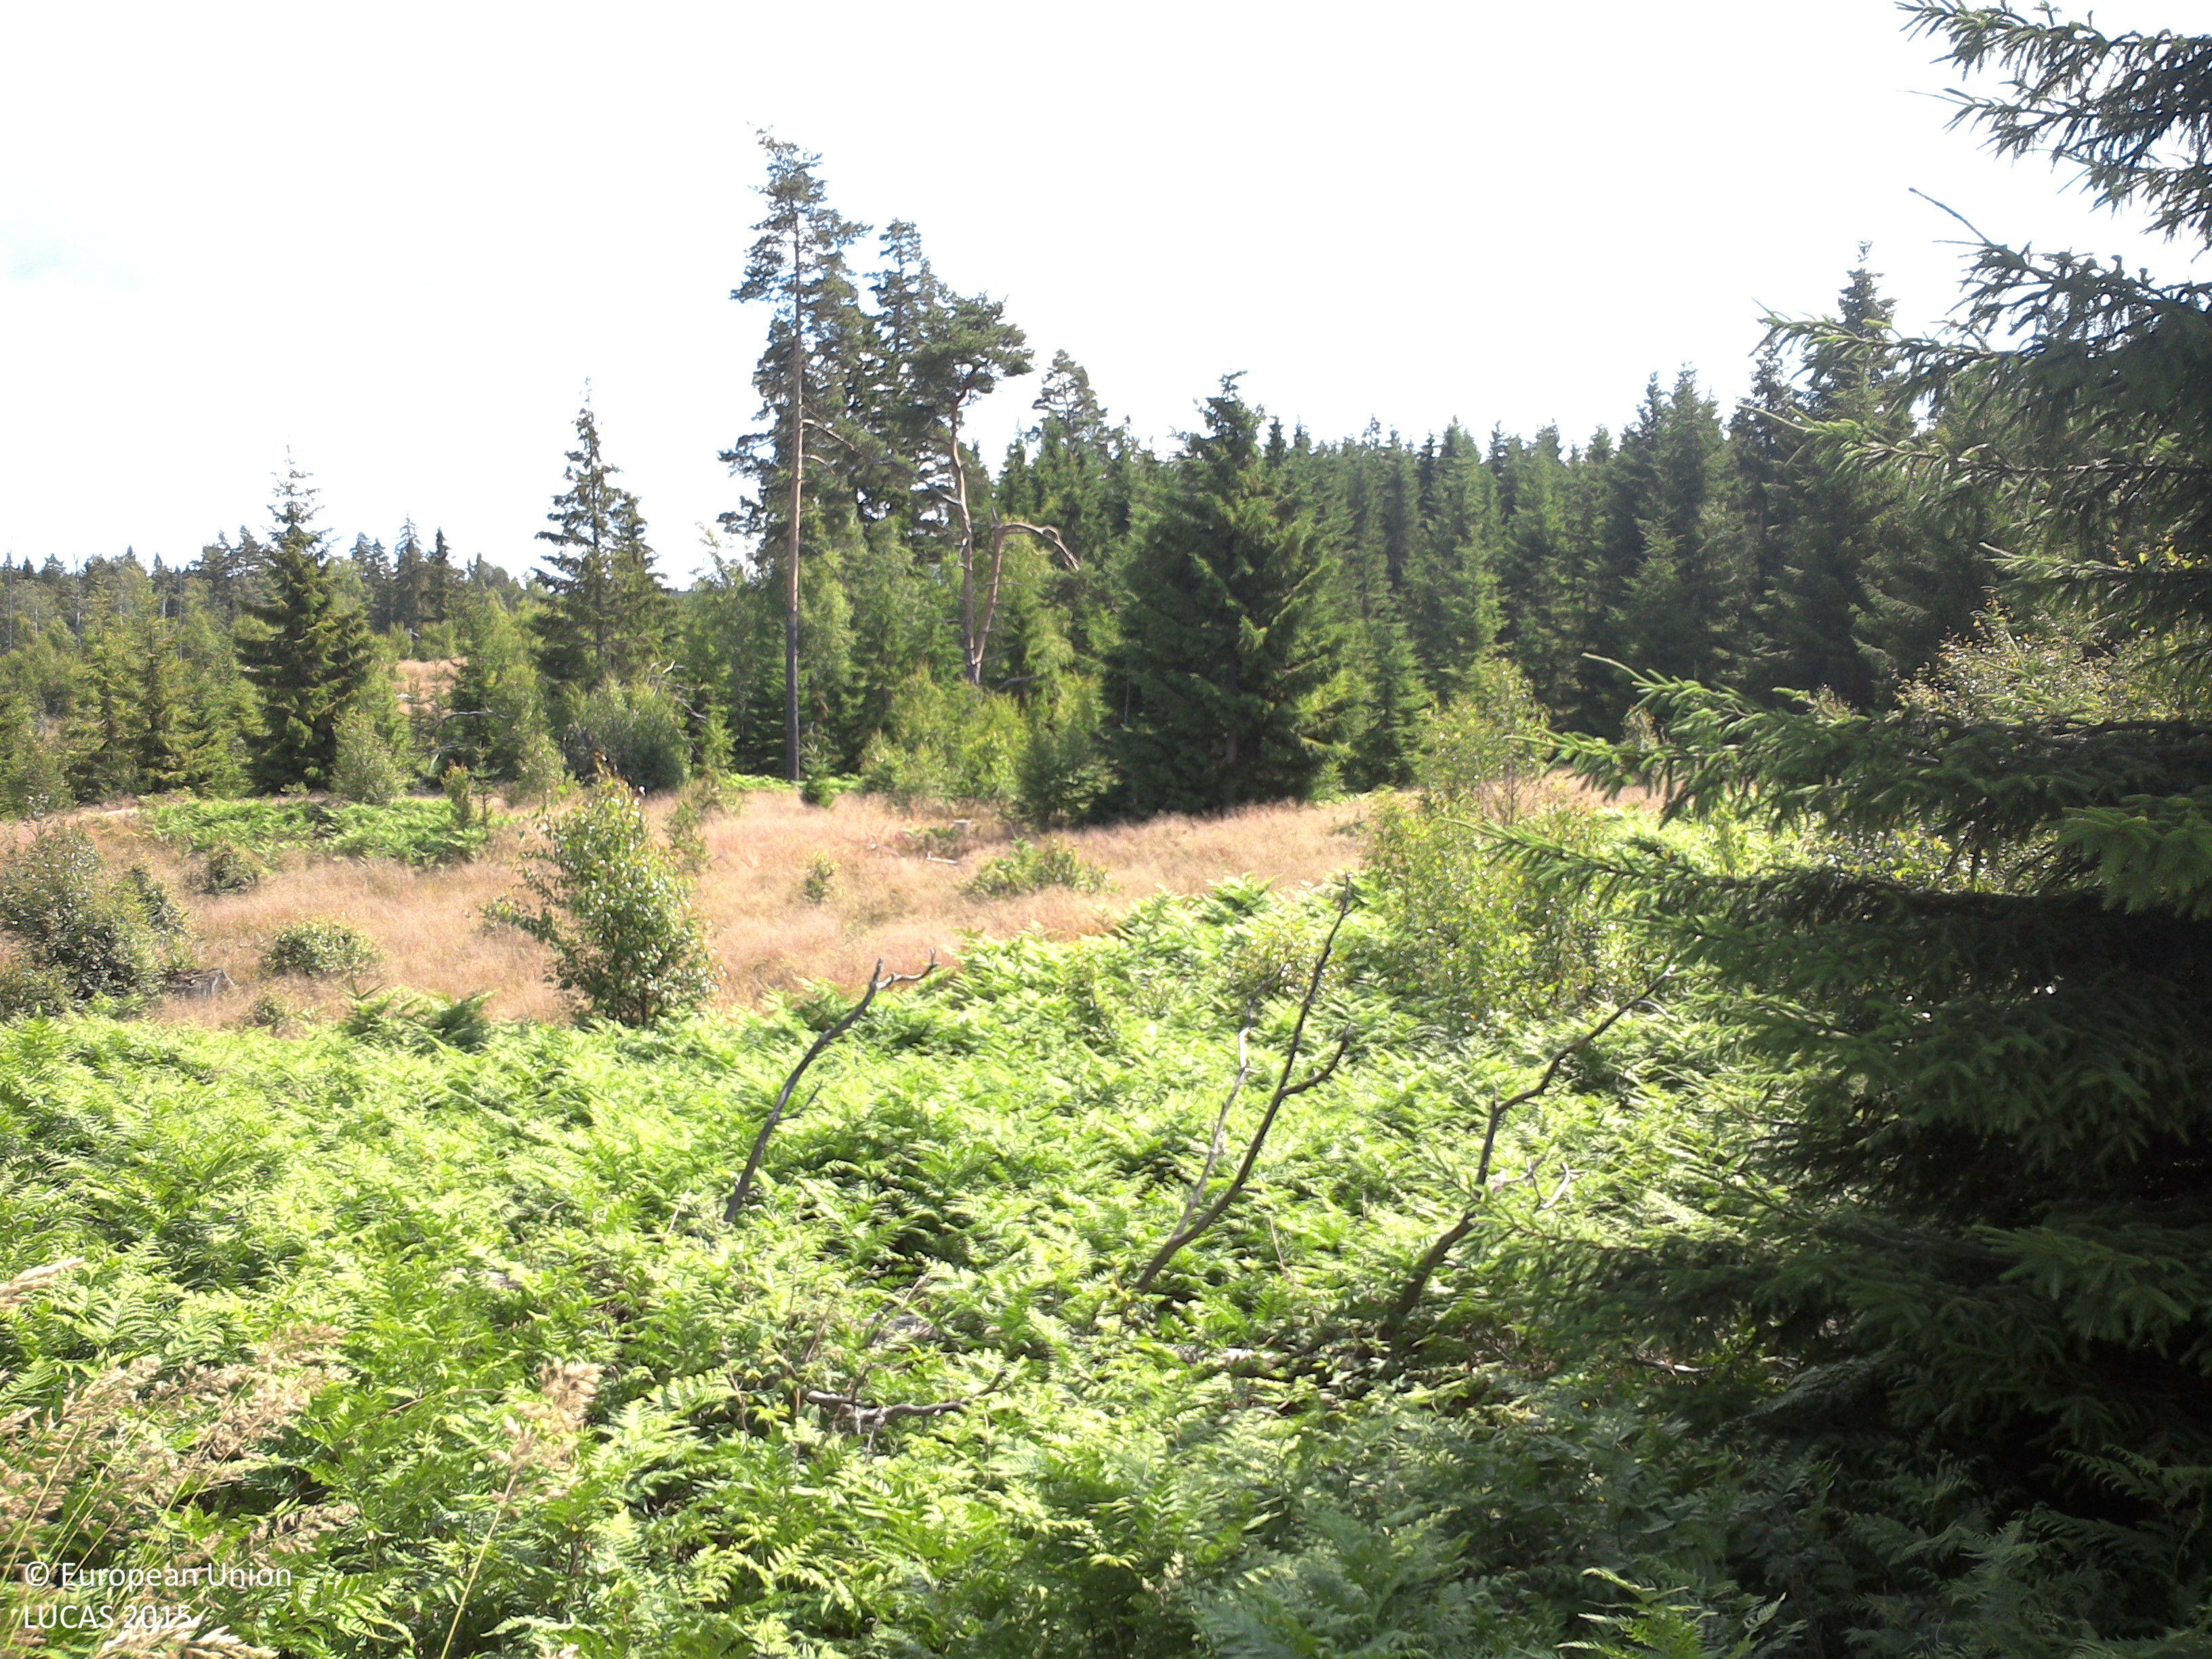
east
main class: Woodland
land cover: Spruce dominated mixed woodland
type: boreal forest
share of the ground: 50 - 75 %
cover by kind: coniferous forest trees 50 %, broadleaved forest trees 25 %, herbaceous plants 15 %, lichens and mosses 10 %
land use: Forestry
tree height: > 5 m
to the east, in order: Spruce dominated mixed woodland; Shrubland with sparse tree cover; Grassland with sparse tree/shrub cover; Spruce dominated coniferous woodland; Pine dominated coniferous woodland; Shrubland with sparse tree cover; Spruce dominated coniferous woodland; Shrubland with sparse tree cover; Broadleaved woodland; Grassland with sparse tree/shrub cover; Spruce dominated coniferous woodland; Spruce dominated mixed woodland; Broadleaved woodland; Spruce dominated coniferous woodland
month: July
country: SE
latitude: 58.0524
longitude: 14.5525
